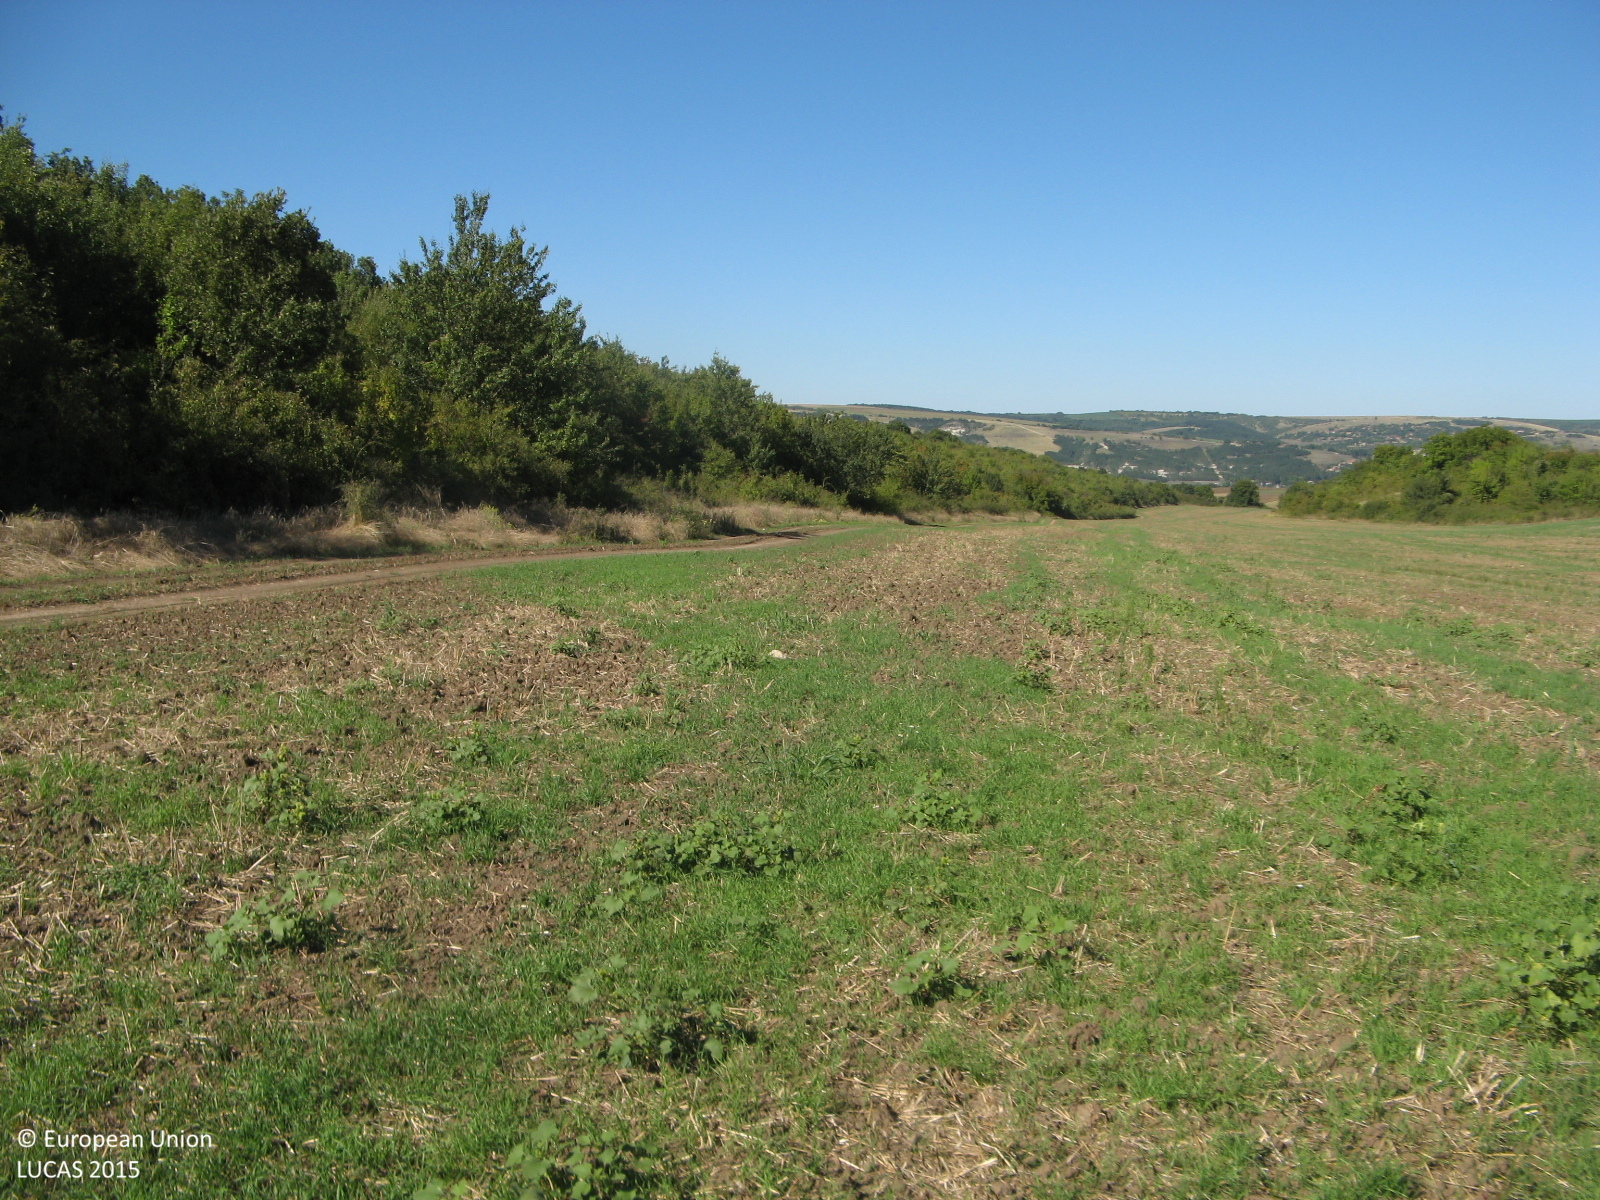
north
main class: Cropland
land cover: Common wheat
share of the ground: < 10 %
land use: Agriculture (excluding fallow land and kitchen gardens)
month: September
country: BG
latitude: 43.4978
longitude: 26.0346
